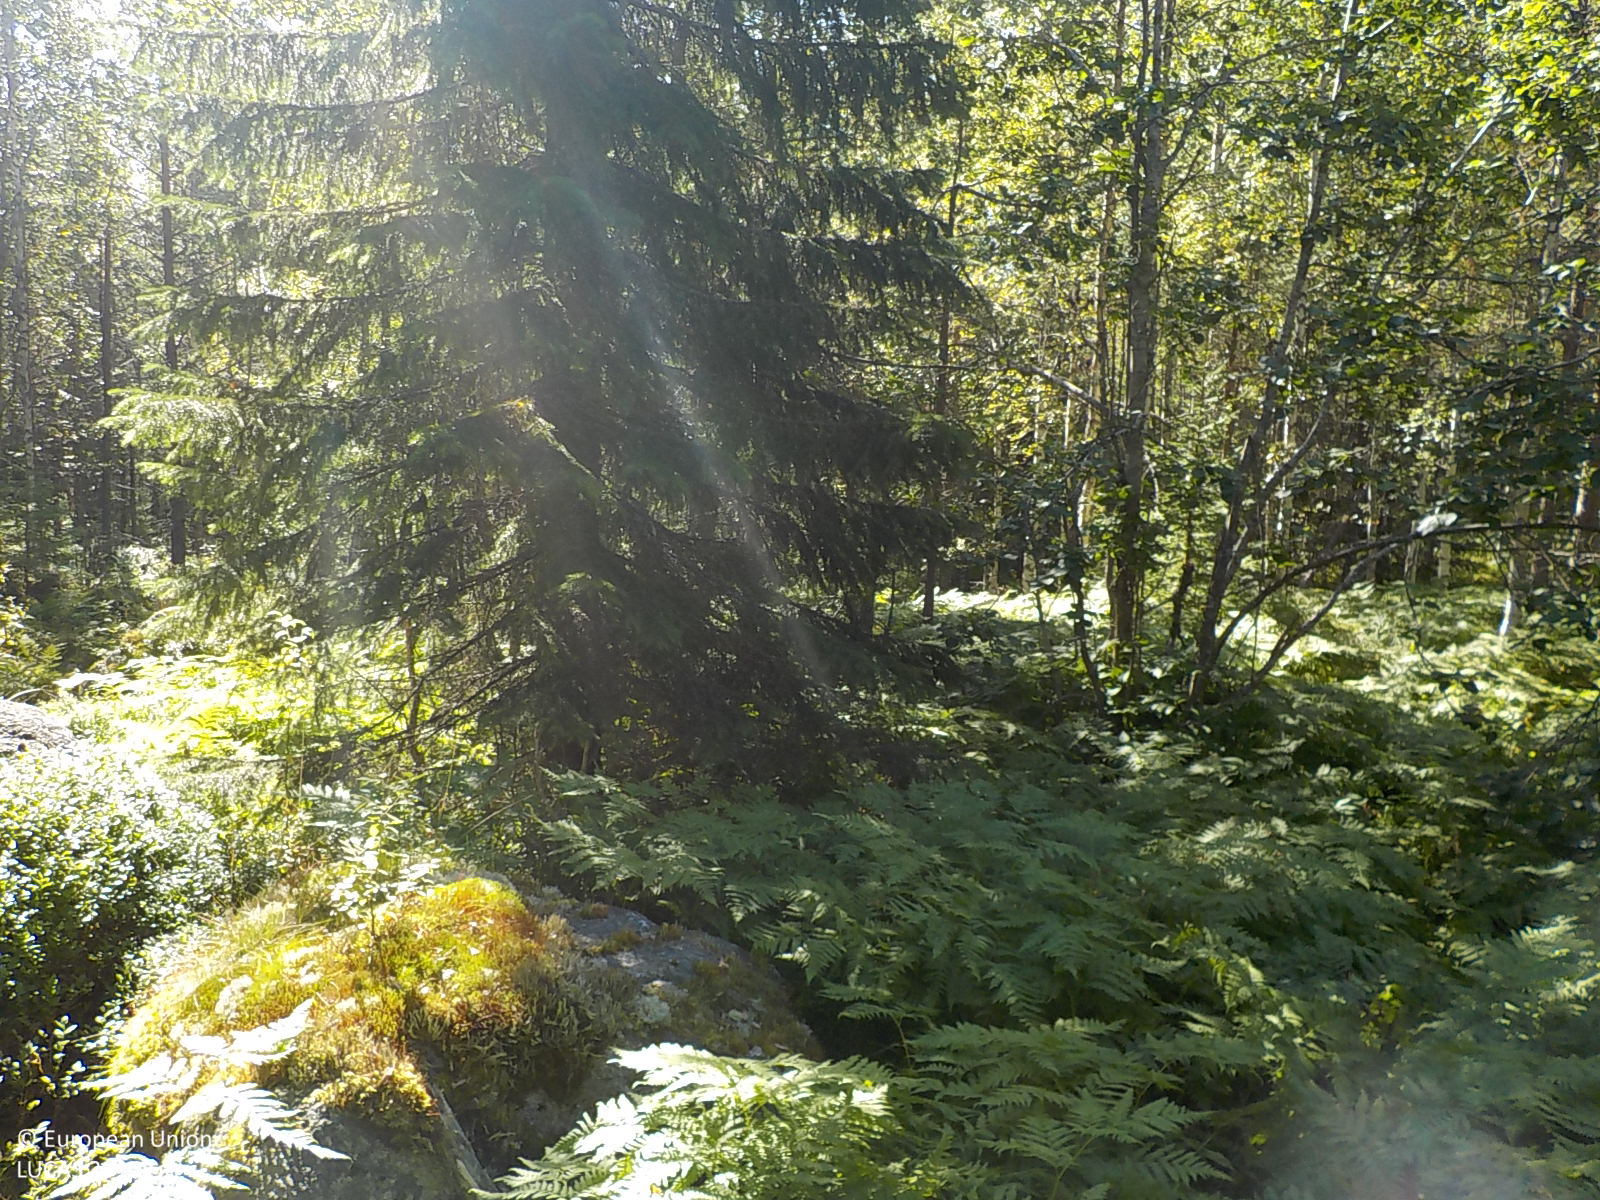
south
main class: Woodland
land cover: Pine dominated coniferous woodland
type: boreal forest
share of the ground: 50 - 75 %
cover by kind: coniferous forest trees 55 %, shrubs 15 %, herbaceous plants 10 %, lichens and mosses 10 %, consolidated bare surface 10 %
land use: Forestry
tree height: > 5 m
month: August
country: SE
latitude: 63.5575
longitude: 18.7321
